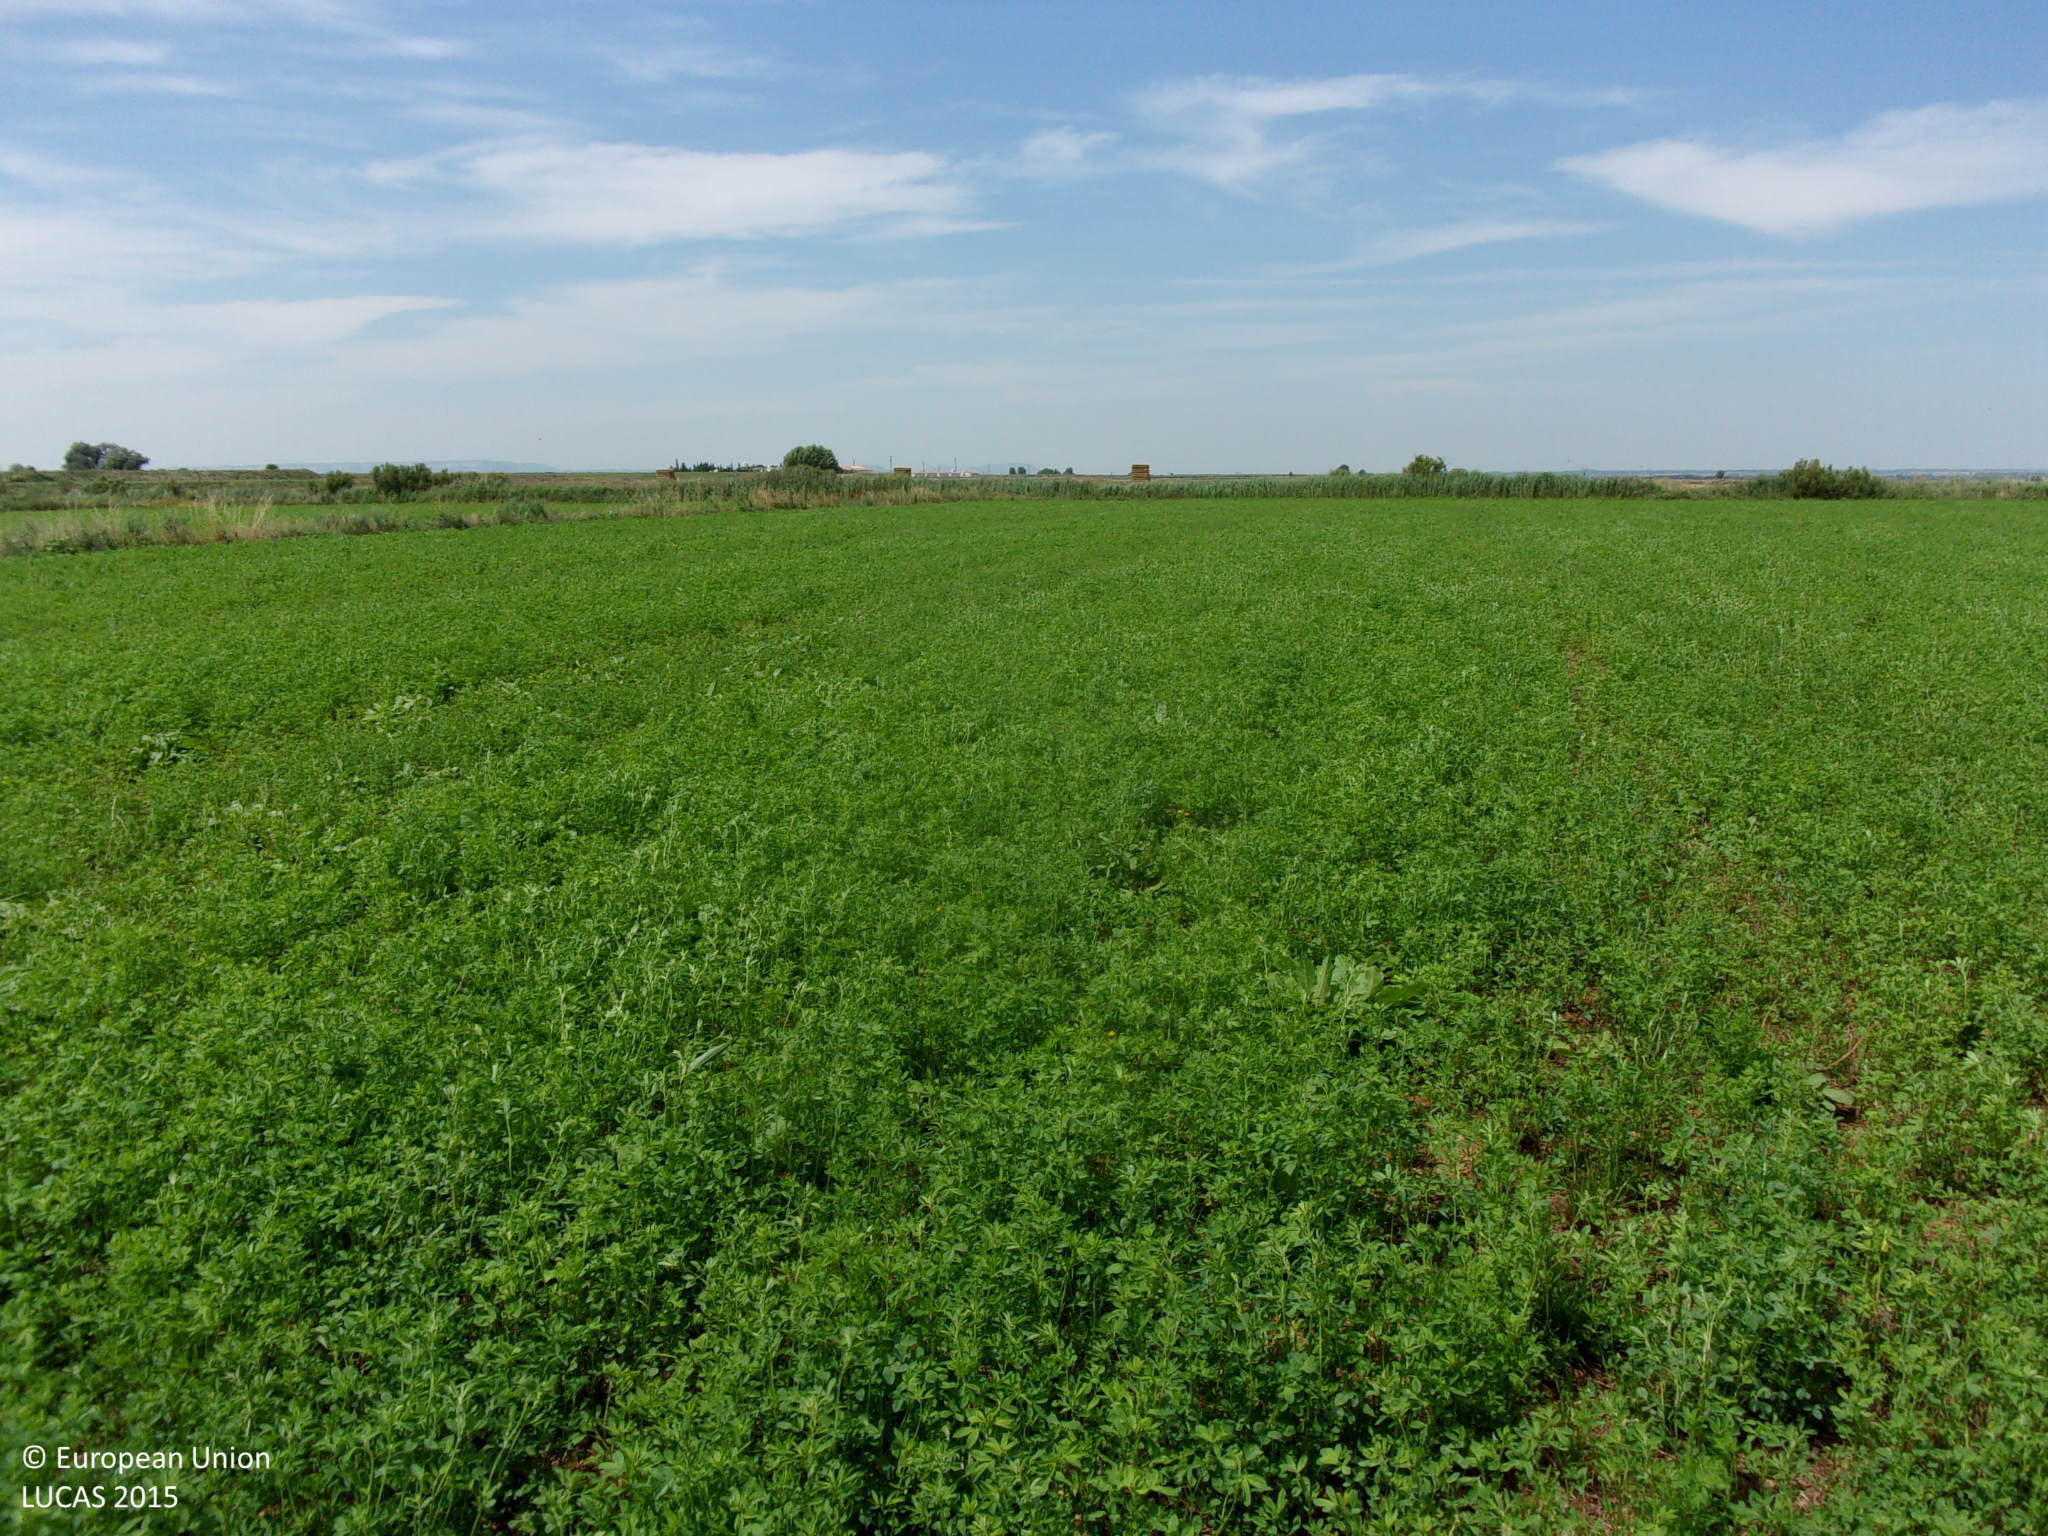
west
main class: Cropland
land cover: Lucerne
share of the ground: > 75 %
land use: Agriculture (excluding fallow land and kitchen gardens)
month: August
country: ES
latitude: 42.1208
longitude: -1.0465
